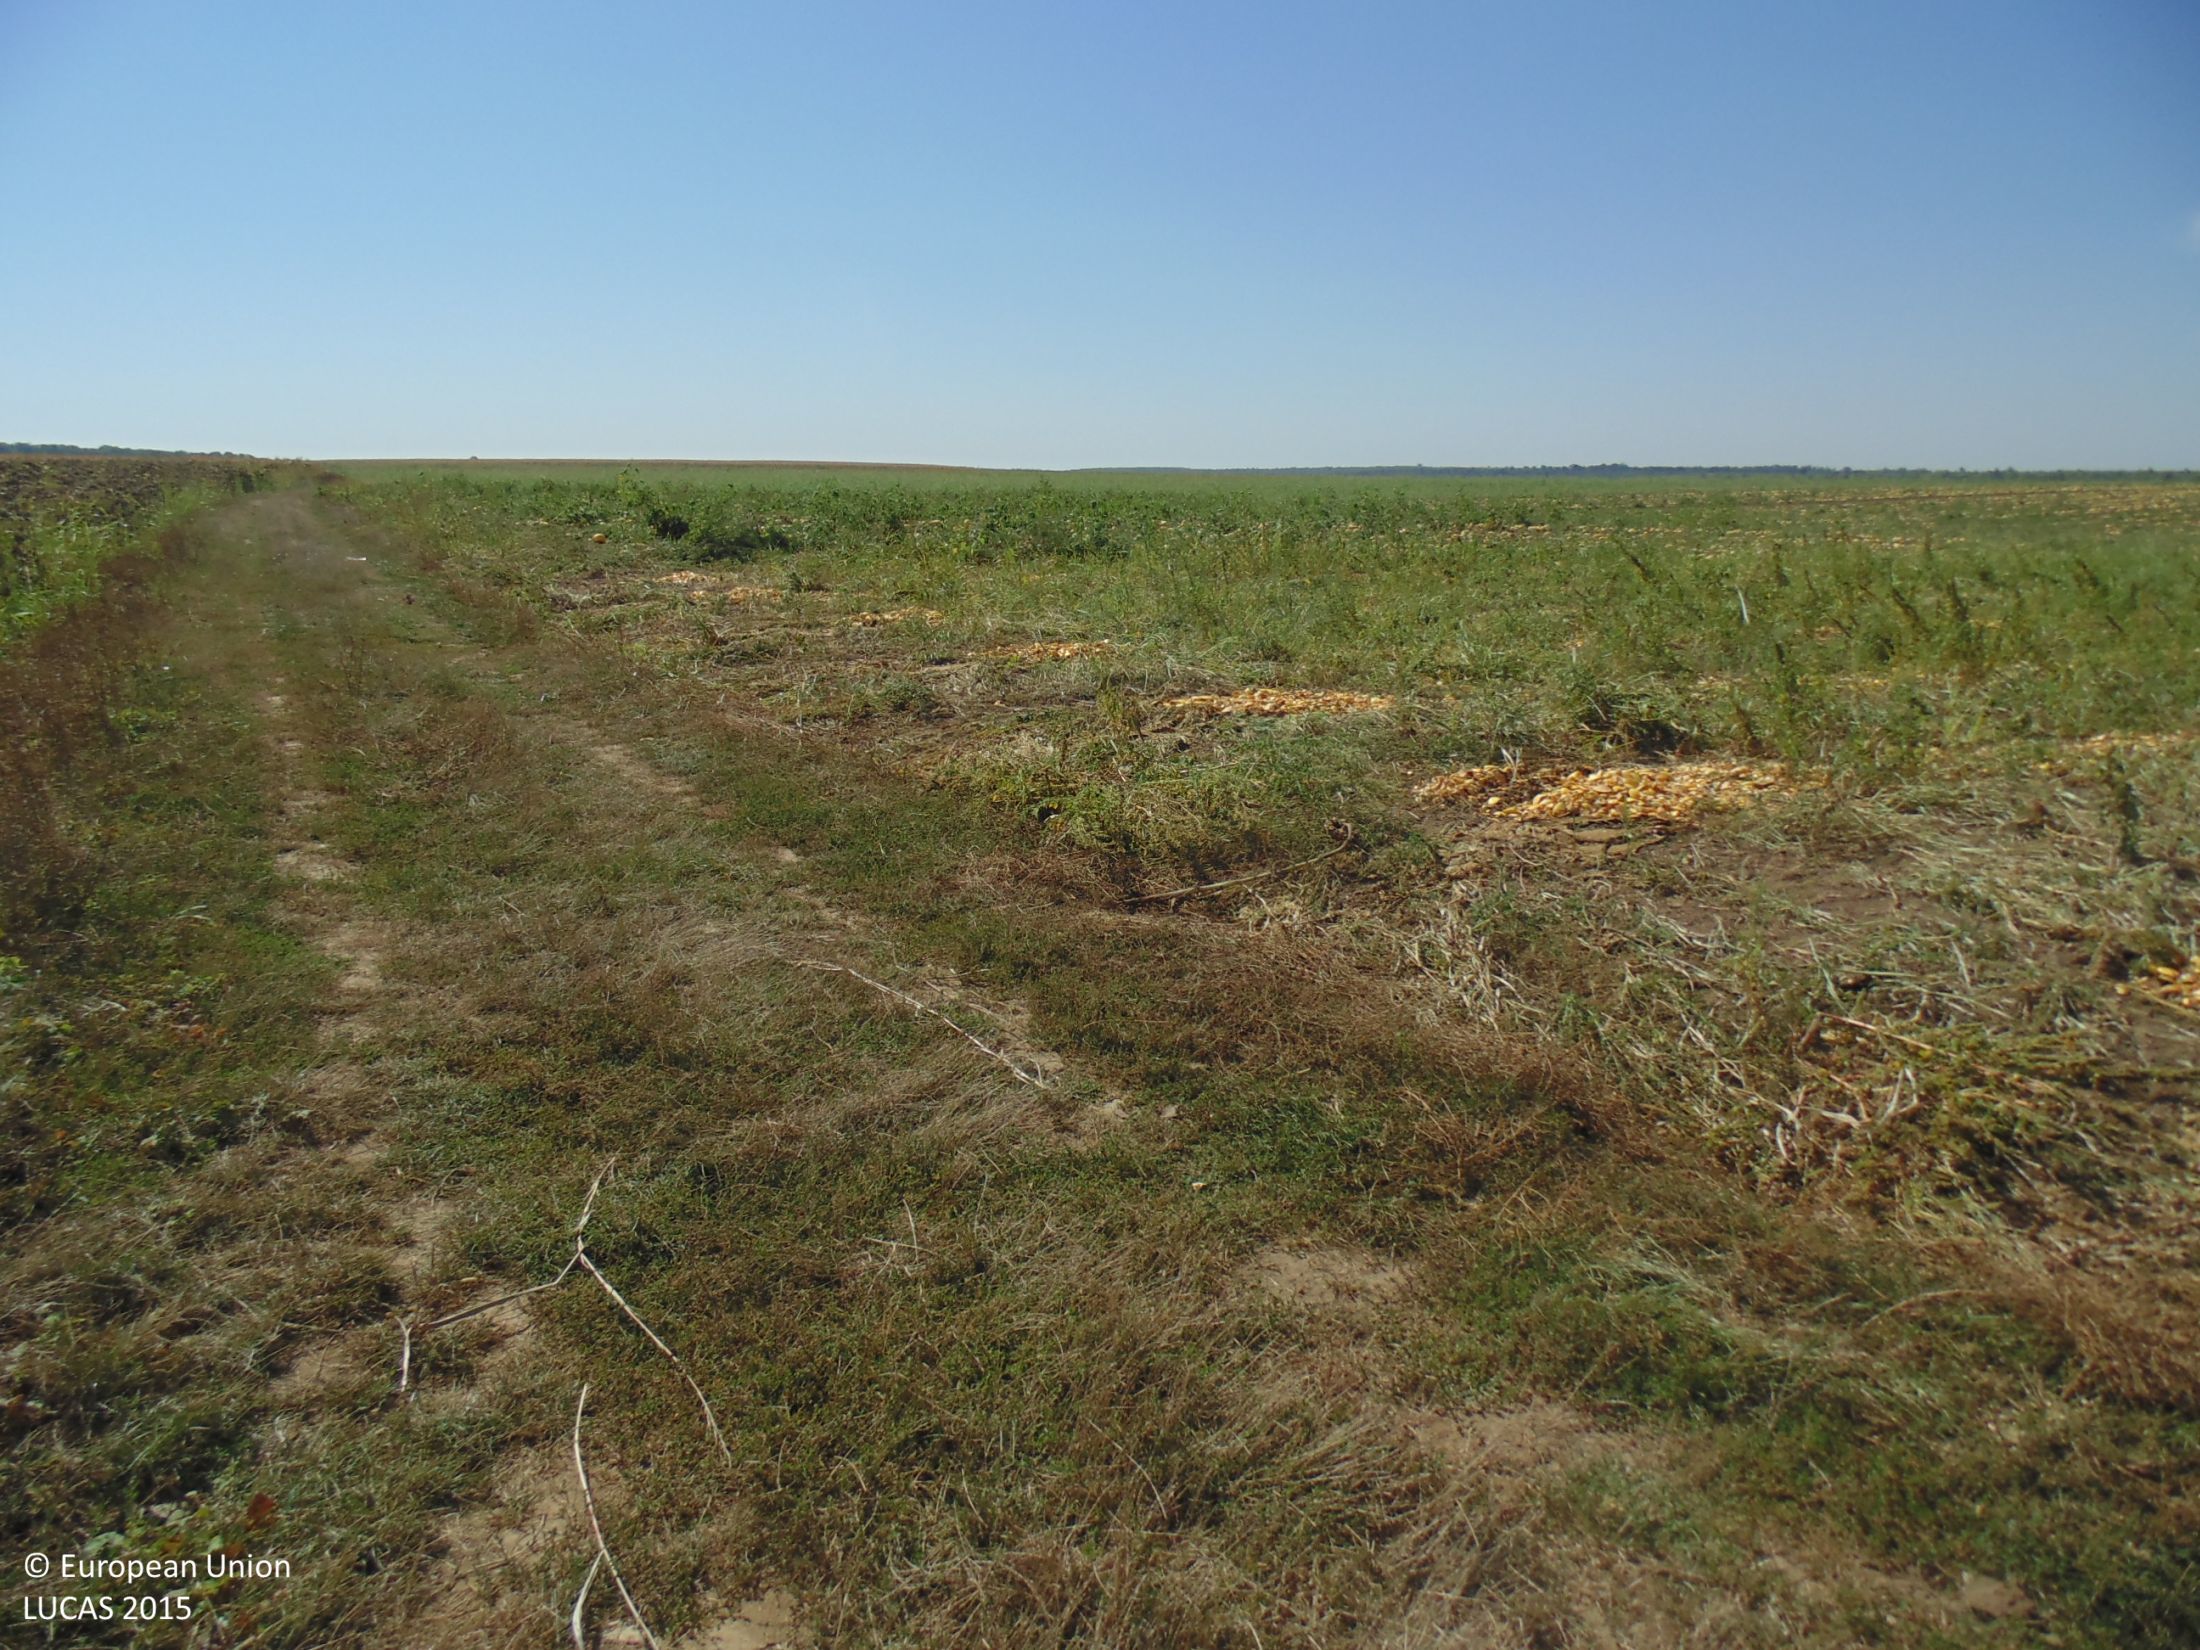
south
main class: Cropland
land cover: Sunflower
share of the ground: > 75 %
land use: Agriculture (excluding fallow land and kitchen gardens)
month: September
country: BG
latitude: 43.8909
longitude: 27.1168
